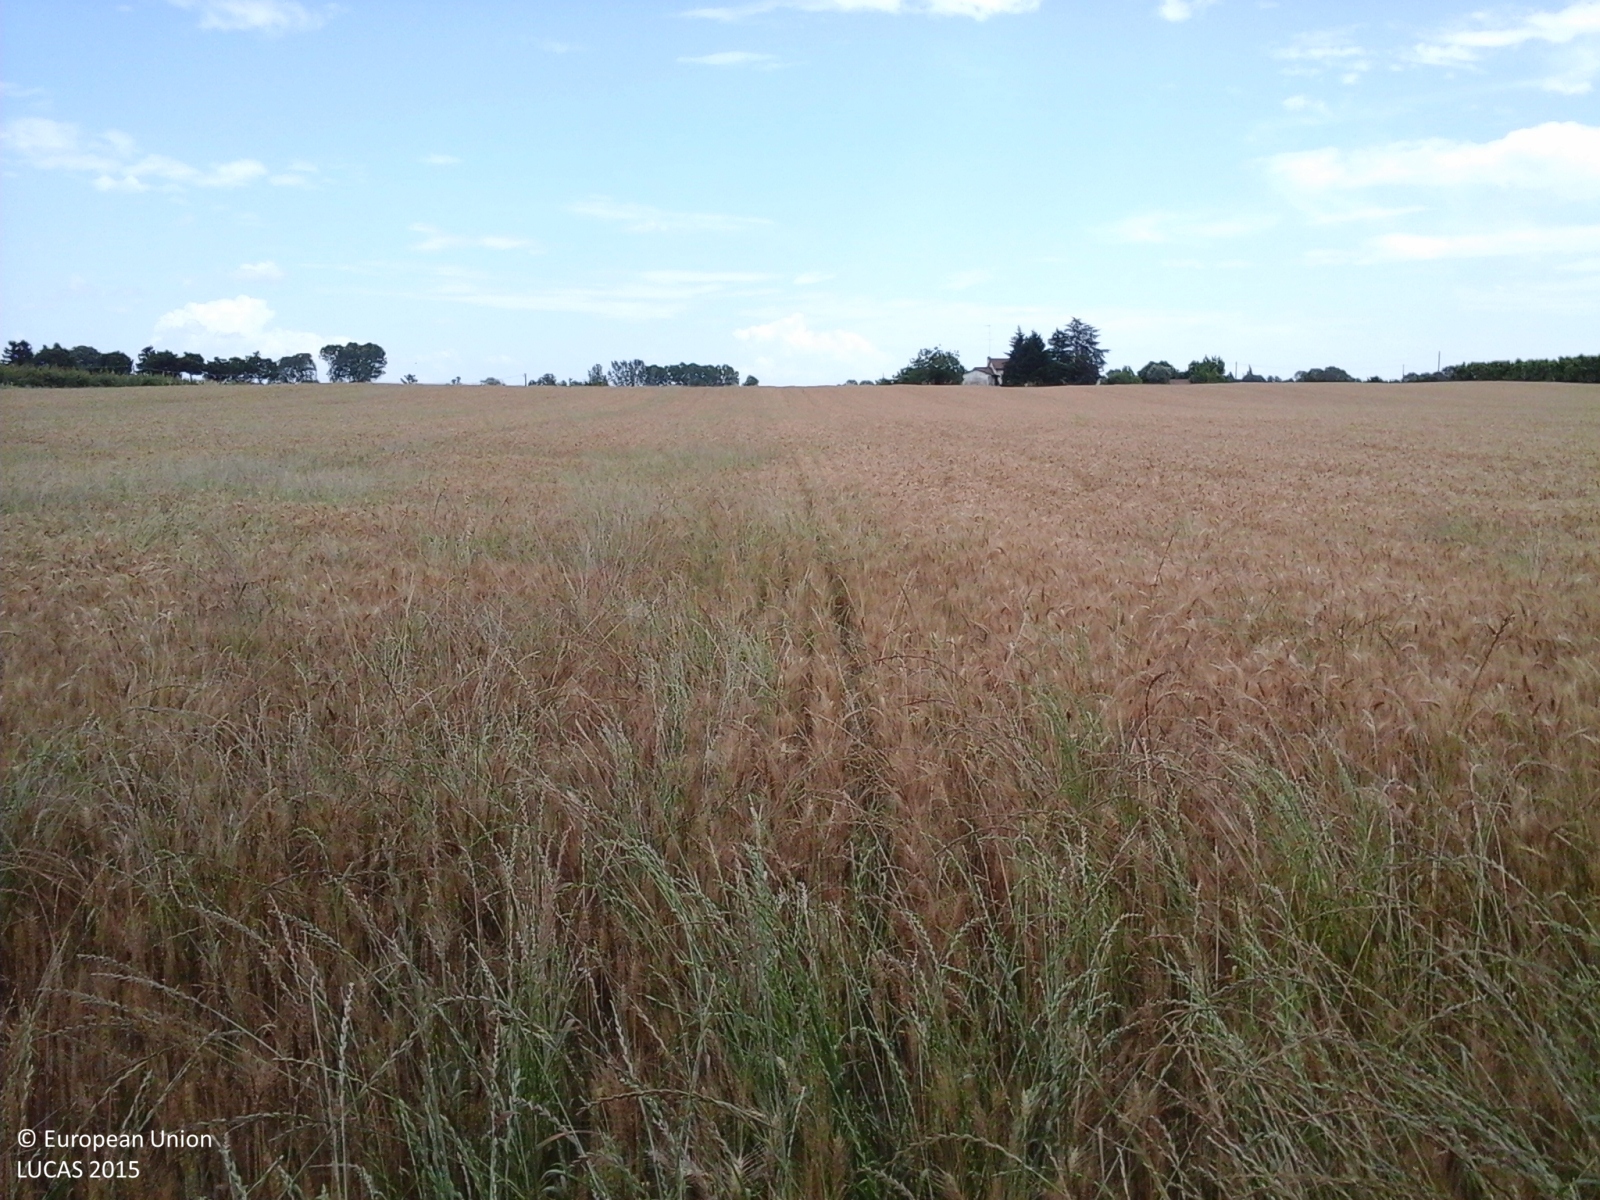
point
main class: Cropland
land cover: Common wheat
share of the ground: > 75 %
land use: Agriculture (excluding fallow land and kitchen gardens)
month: June
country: IT
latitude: 44.2432
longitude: 11.8866
